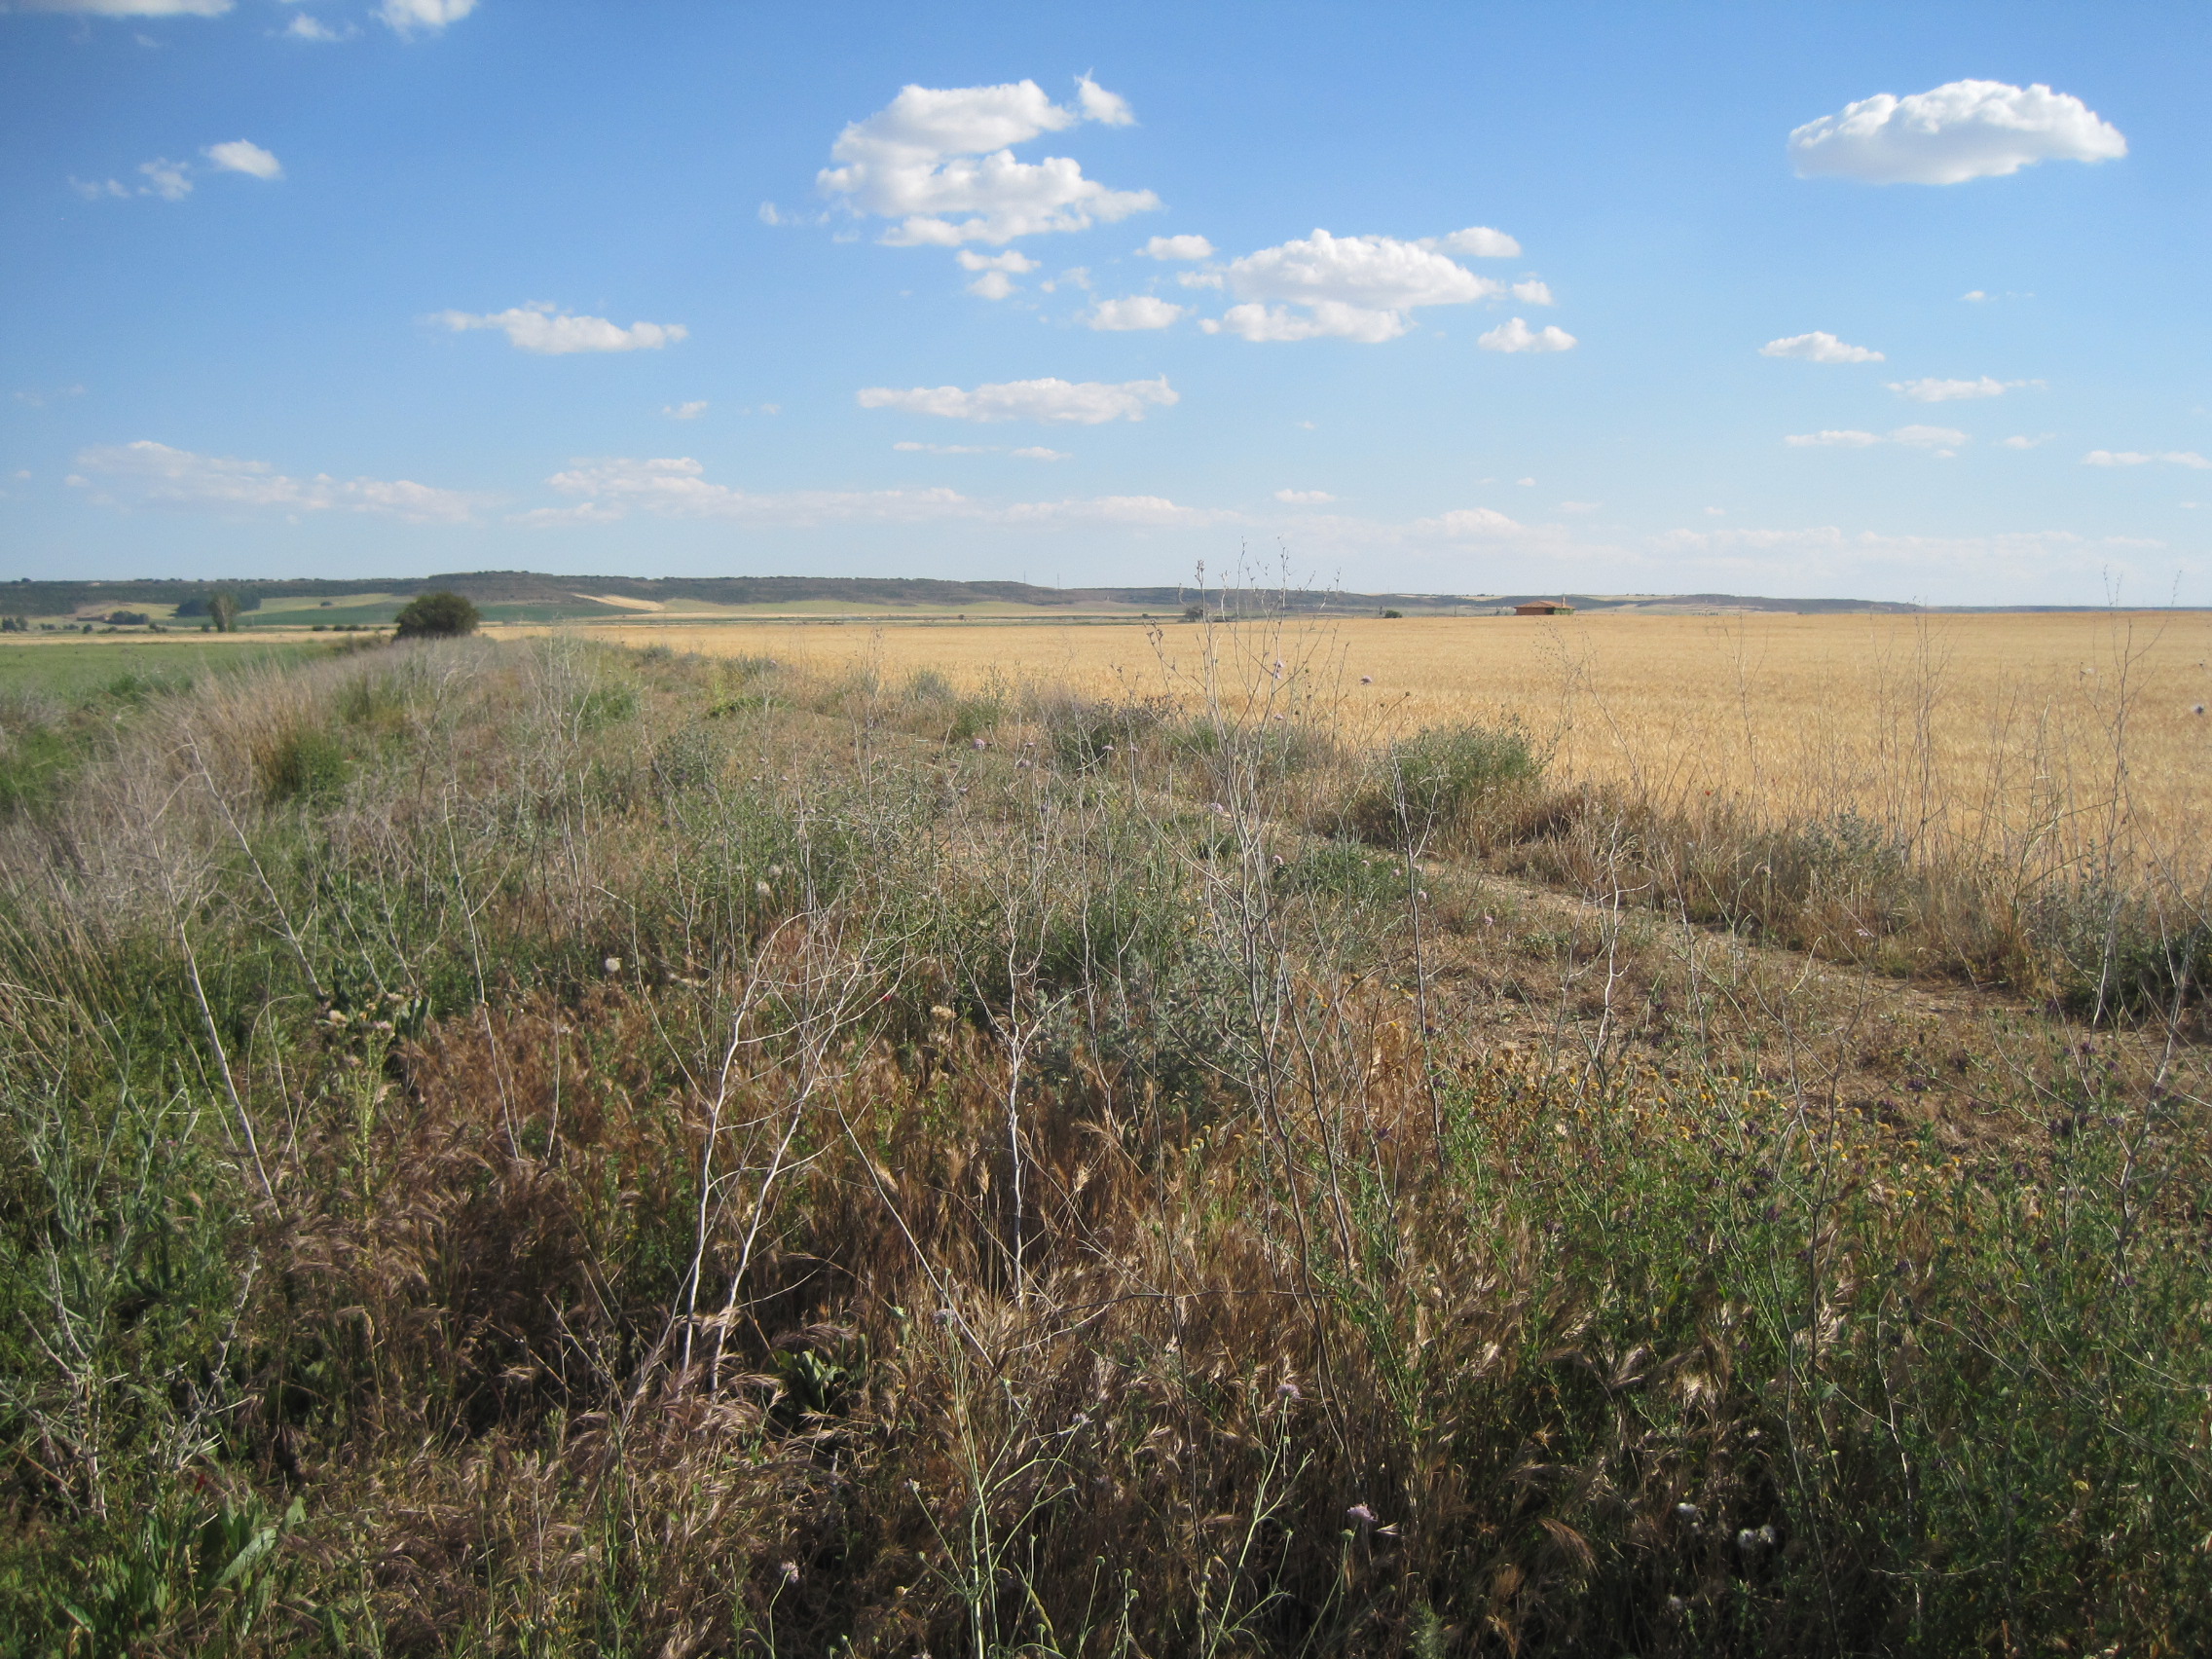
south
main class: Cropland
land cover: Common wheat
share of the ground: > 75 %
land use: Agriculture (excluding fallow land and kitchen gardens)
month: June
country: ES
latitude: 41.7528
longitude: -5.2206
